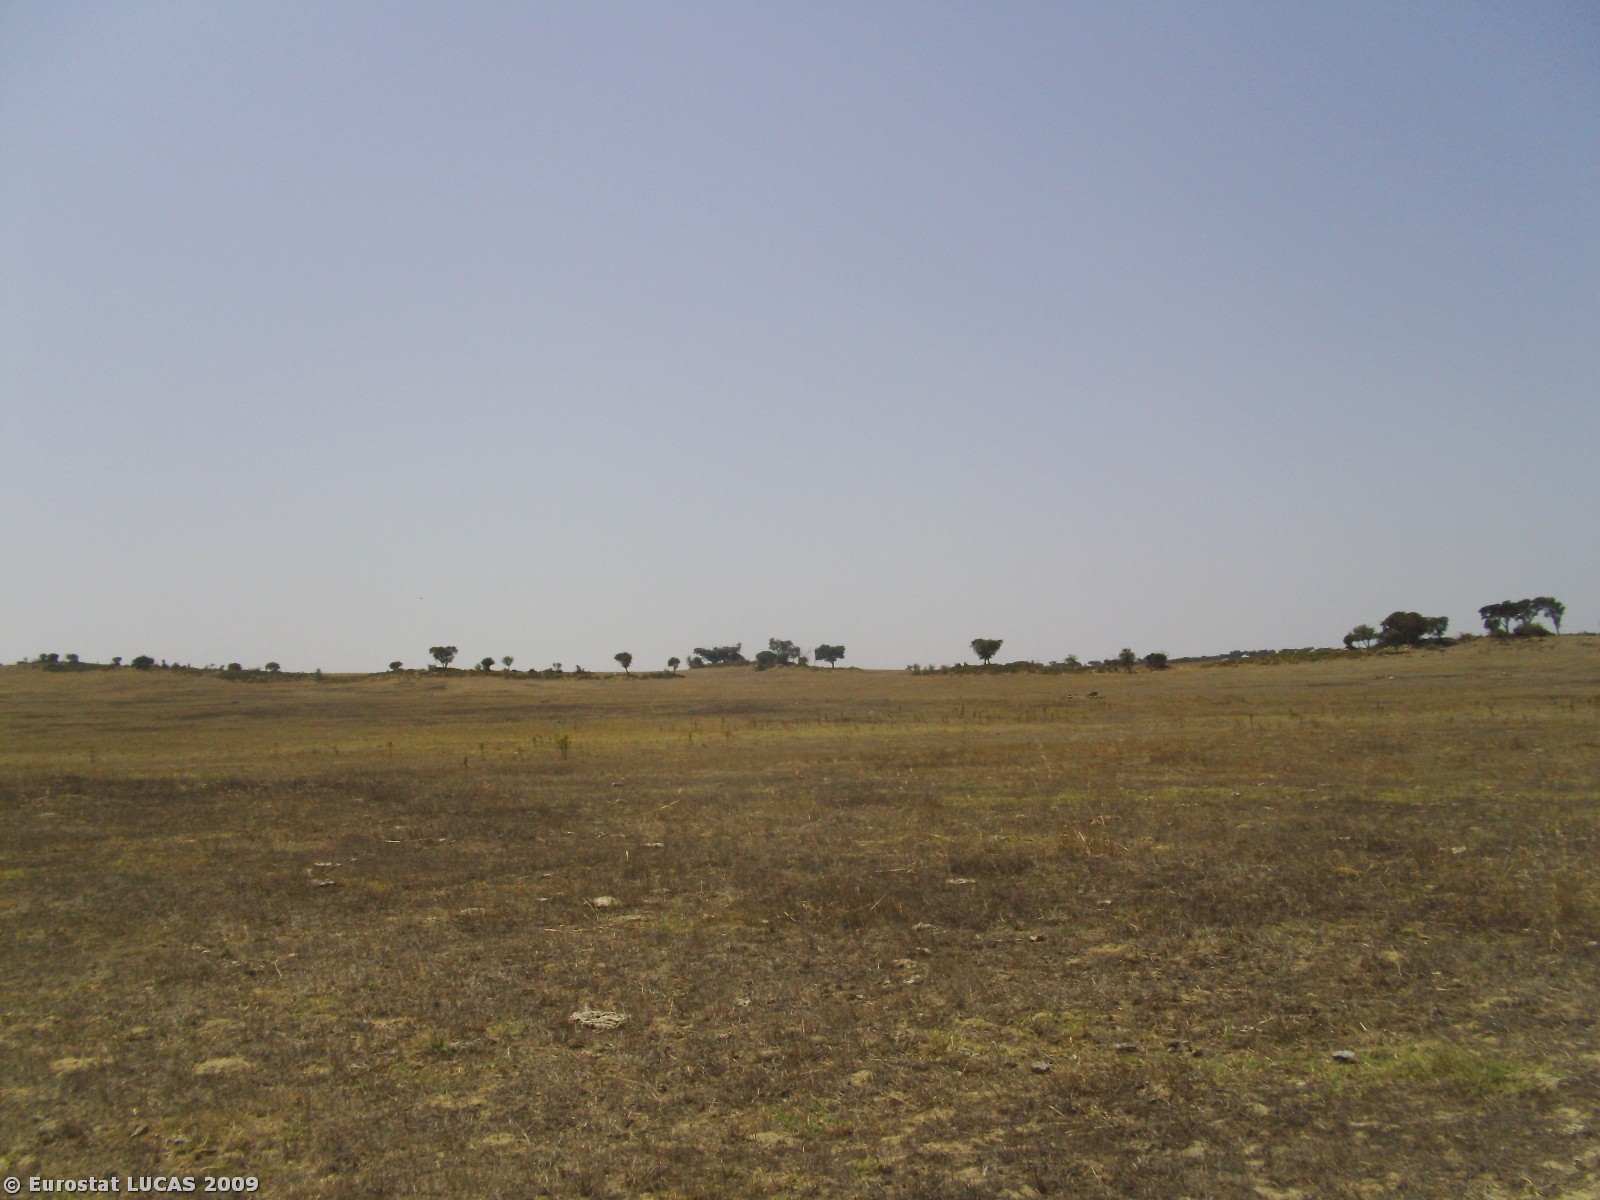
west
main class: Grassland
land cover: Grassland without tree/shrub cover
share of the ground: 25 - 50 %
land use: Agriculture (excluding fallow land and kitchen gardens)
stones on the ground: < 10 %
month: August
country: PT
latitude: 38.4278
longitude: -8.0590
